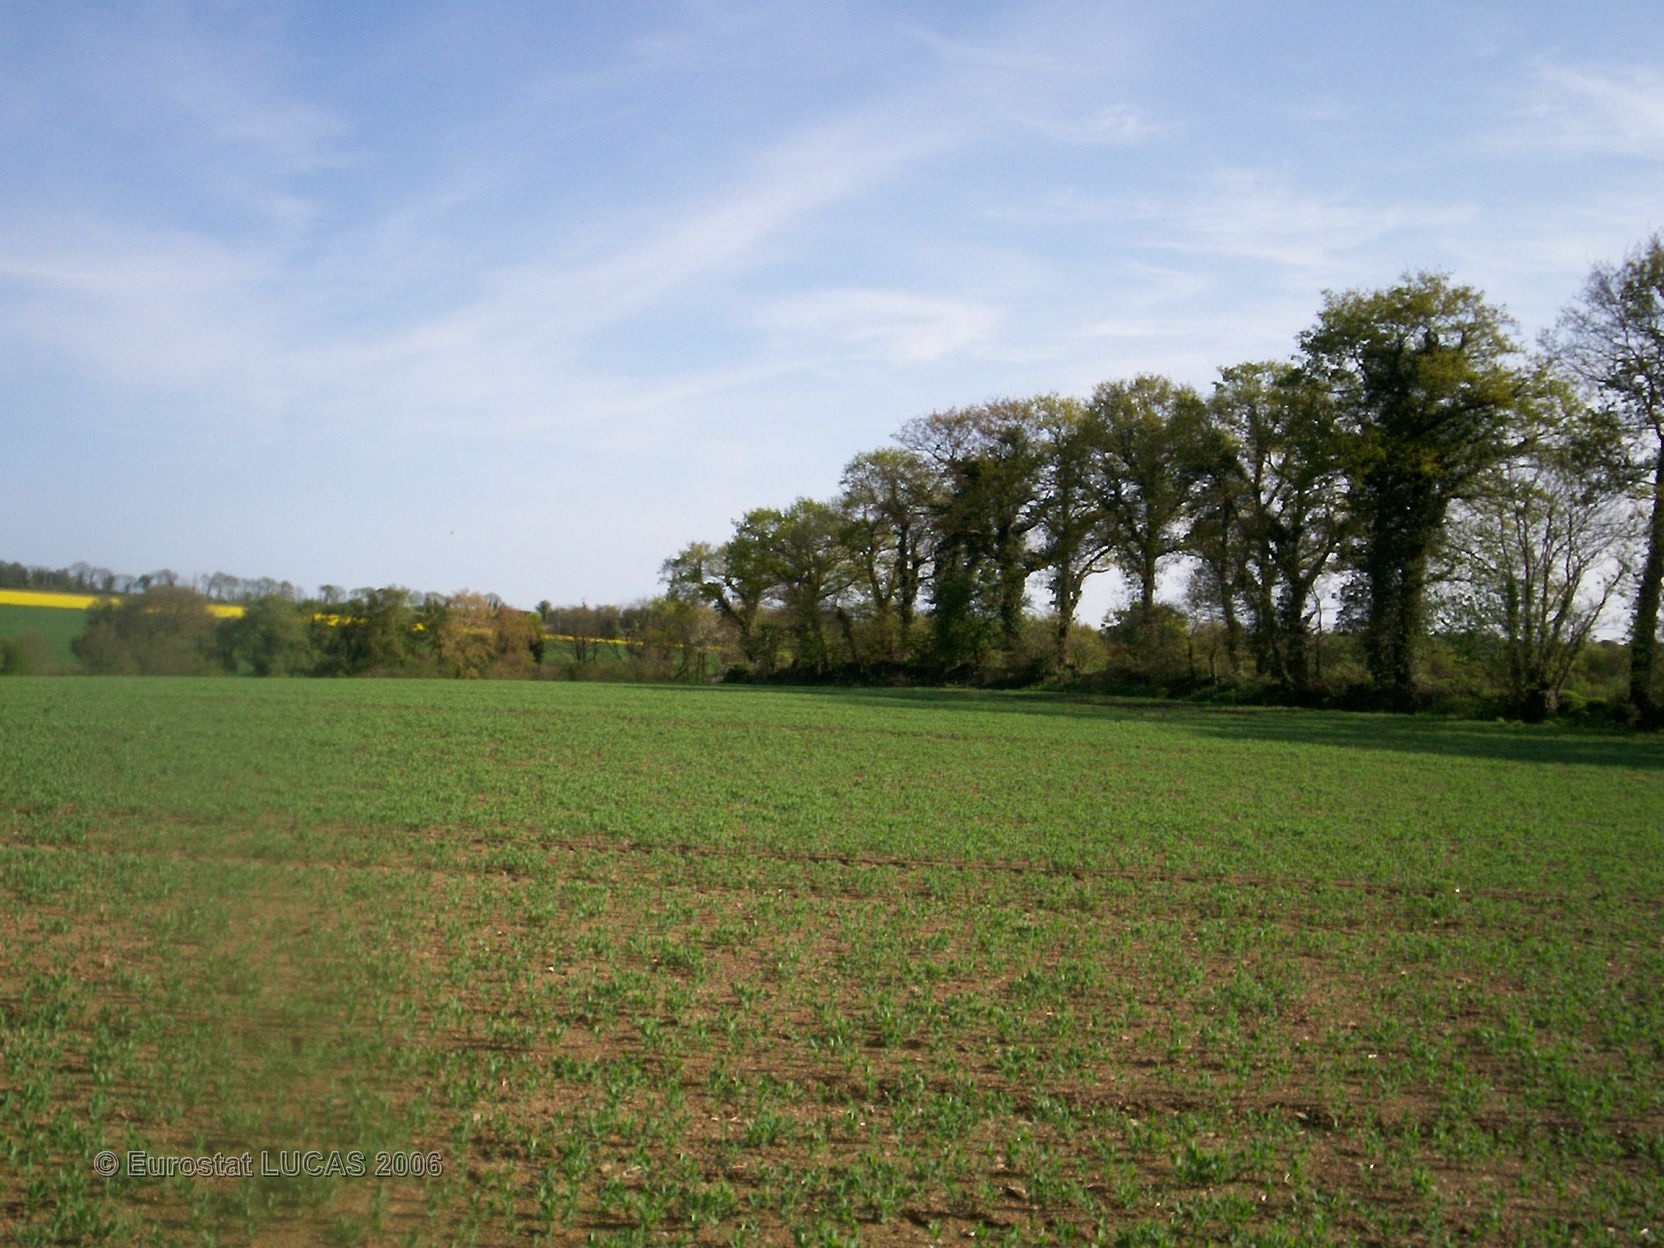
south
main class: Cropland
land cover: Dry pulses
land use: Agriculture (excluding fallow land and kitchen gardens)
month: May
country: FR
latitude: 47.9706
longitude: -2.9119
